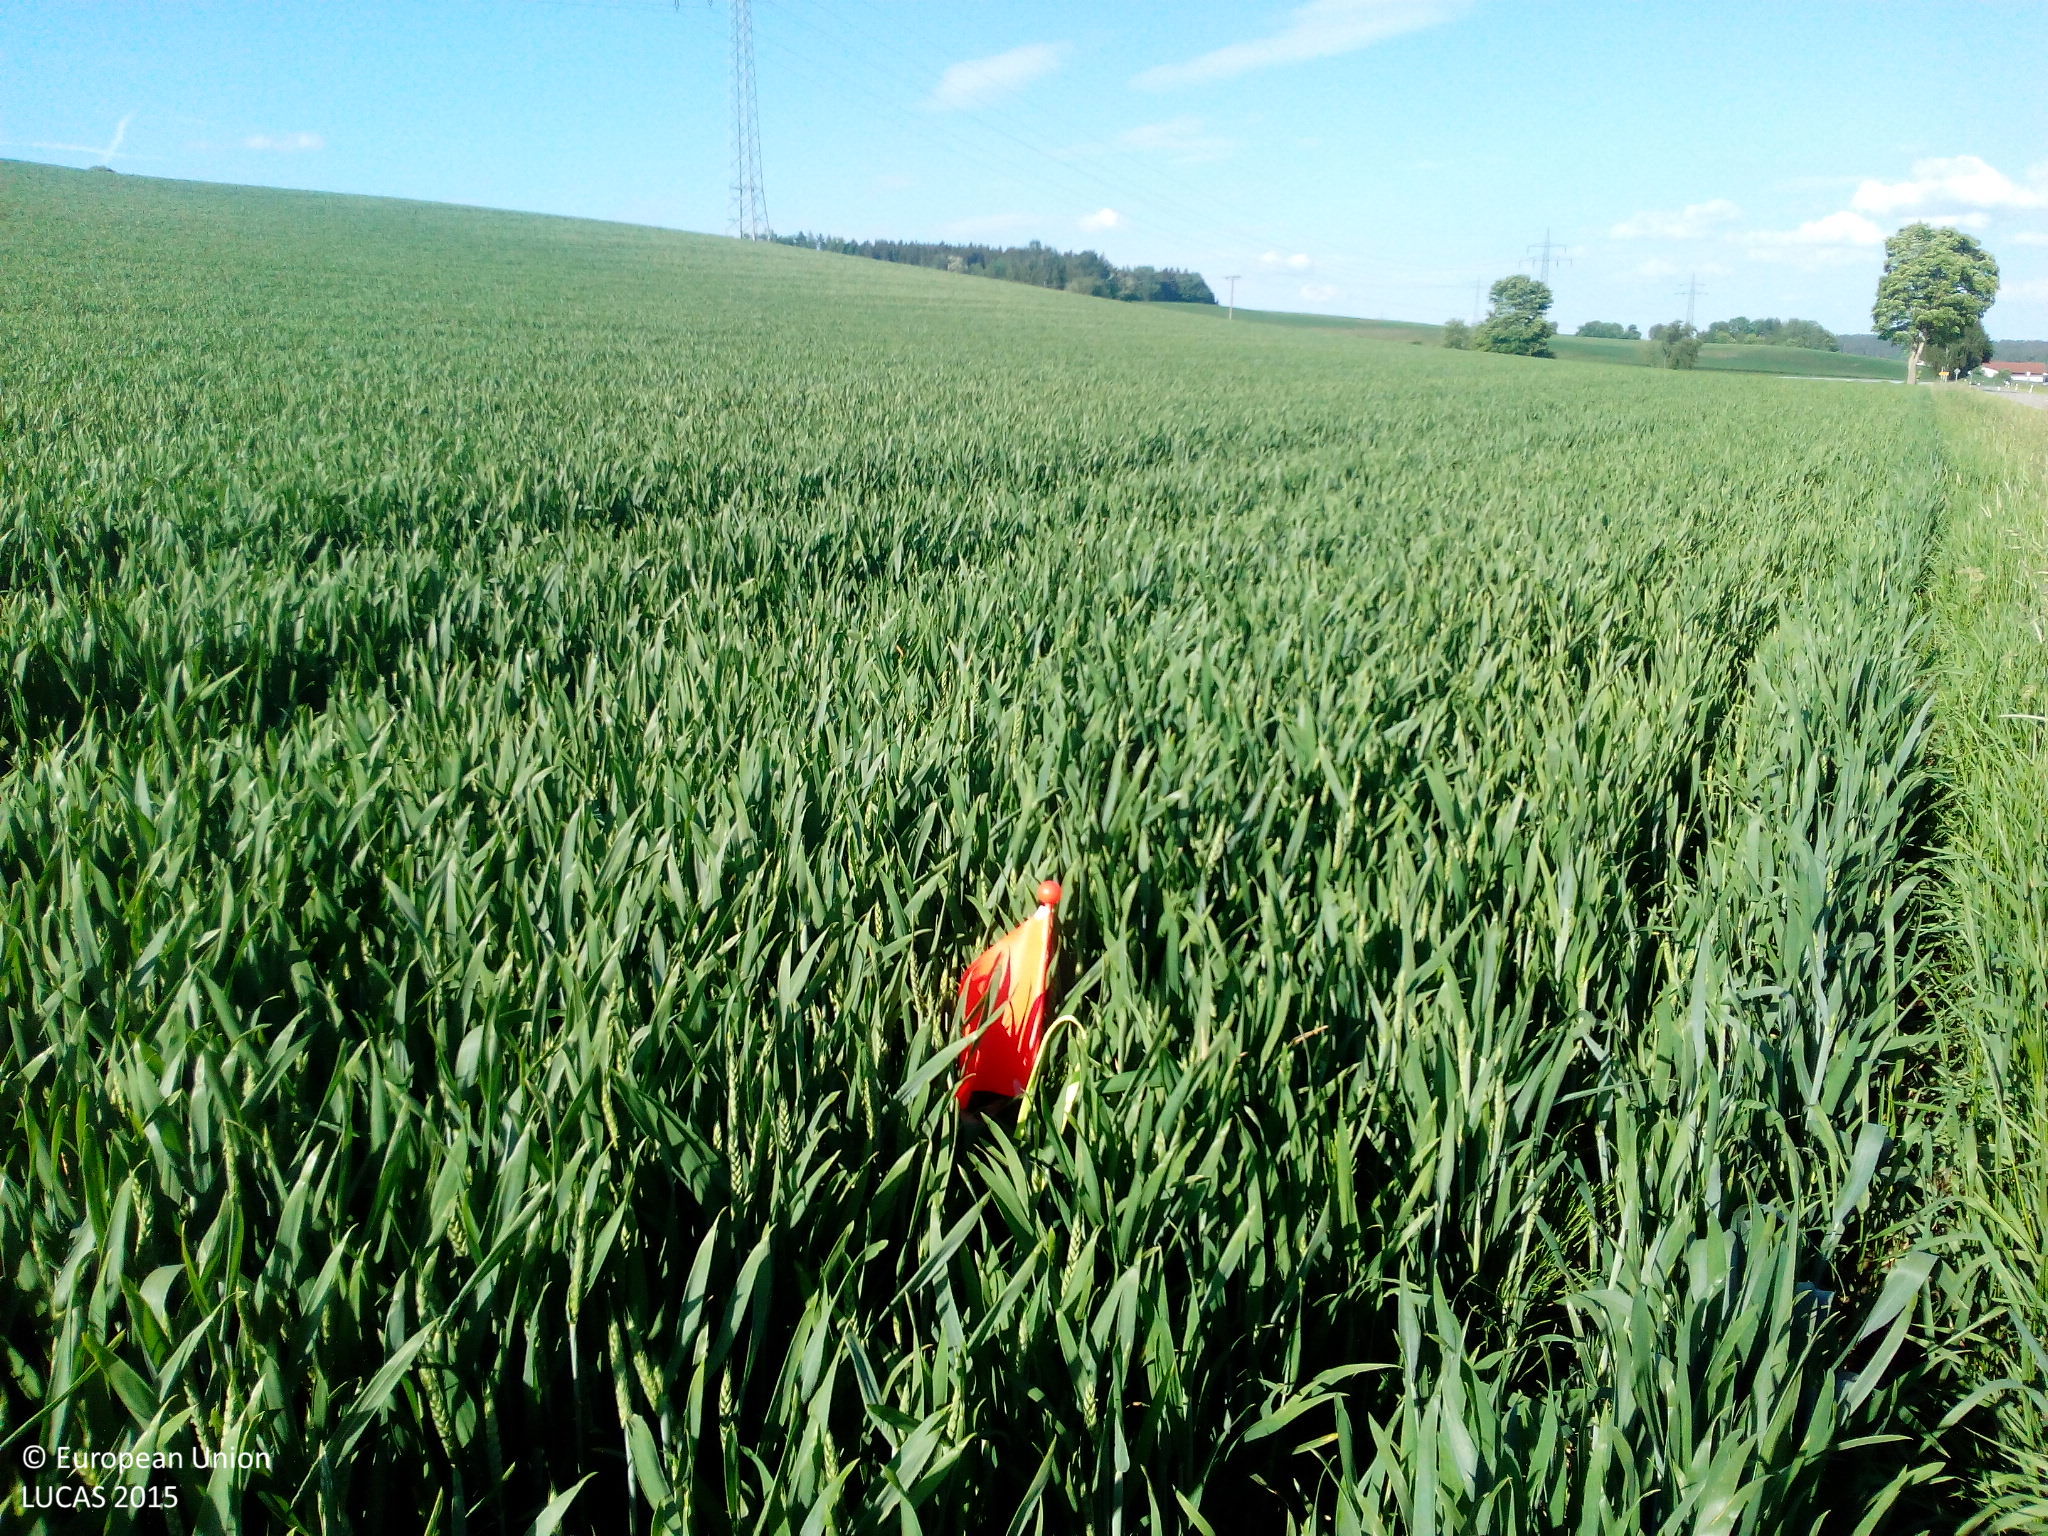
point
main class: Cropland
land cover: Common wheat
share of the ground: > 75 %
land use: Agriculture (excluding fallow land and kitchen gardens)
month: June
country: DE
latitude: 48.7079
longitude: 12.0784
